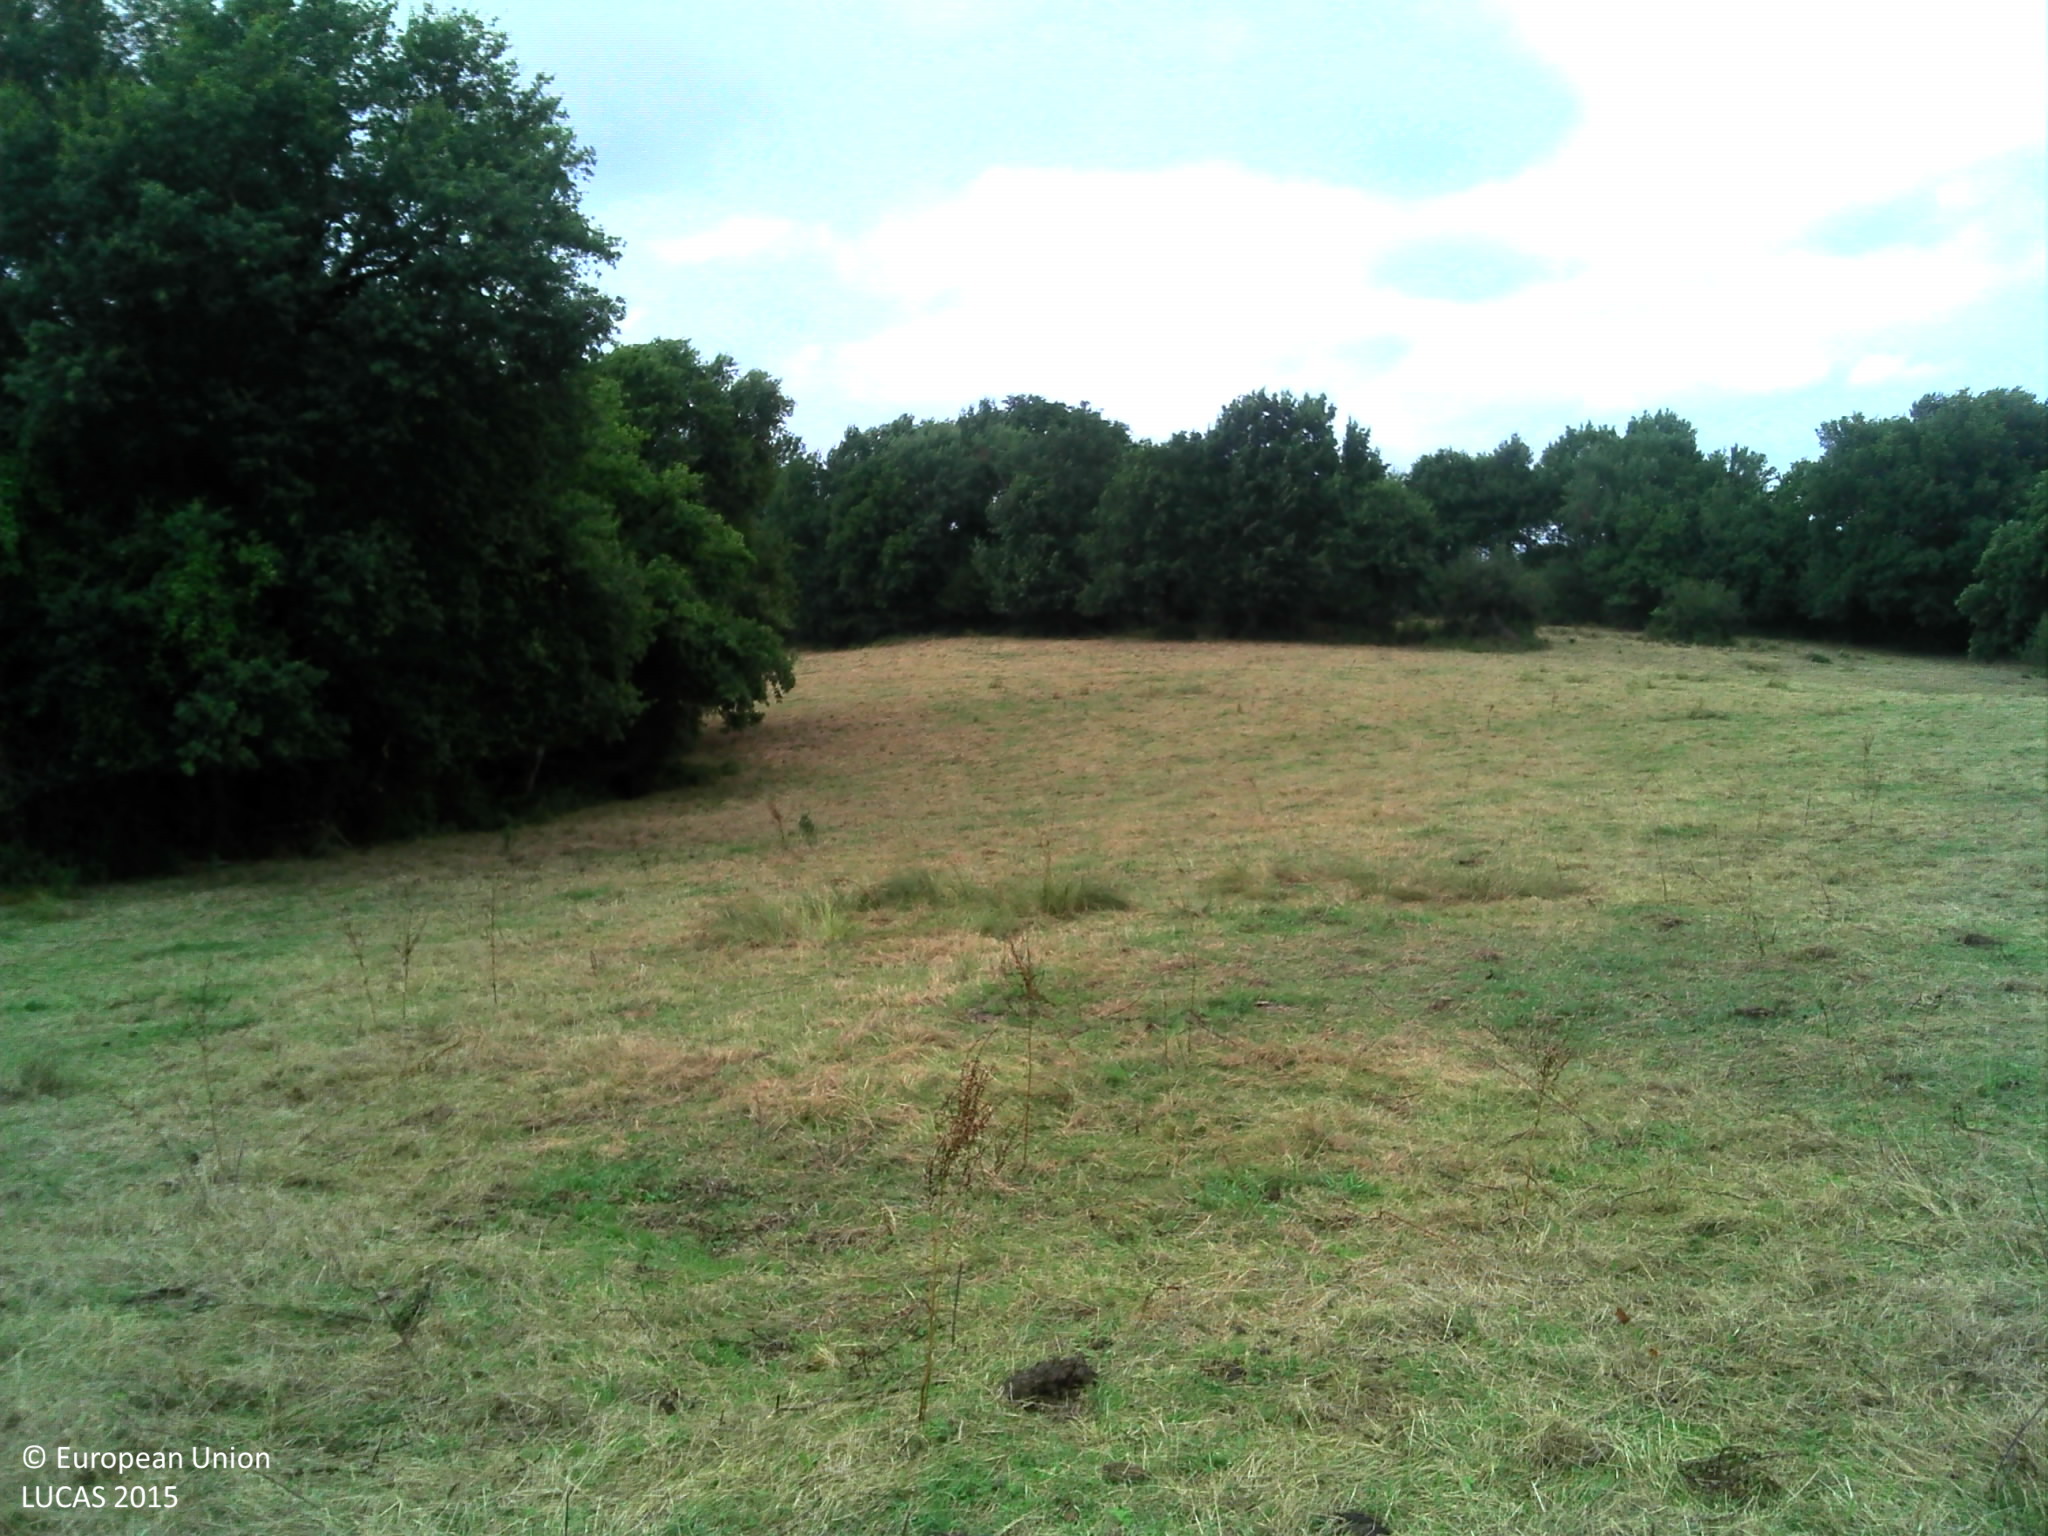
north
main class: Grassland
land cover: Grassland without tree/shrub cover
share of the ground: > 75 %
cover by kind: herbaceous plants 95 %, shrubs 5 %
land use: Agriculture (excluding fallow land and kitchen gardens)
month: August
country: FR
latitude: 43.3523
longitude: -1.1049
